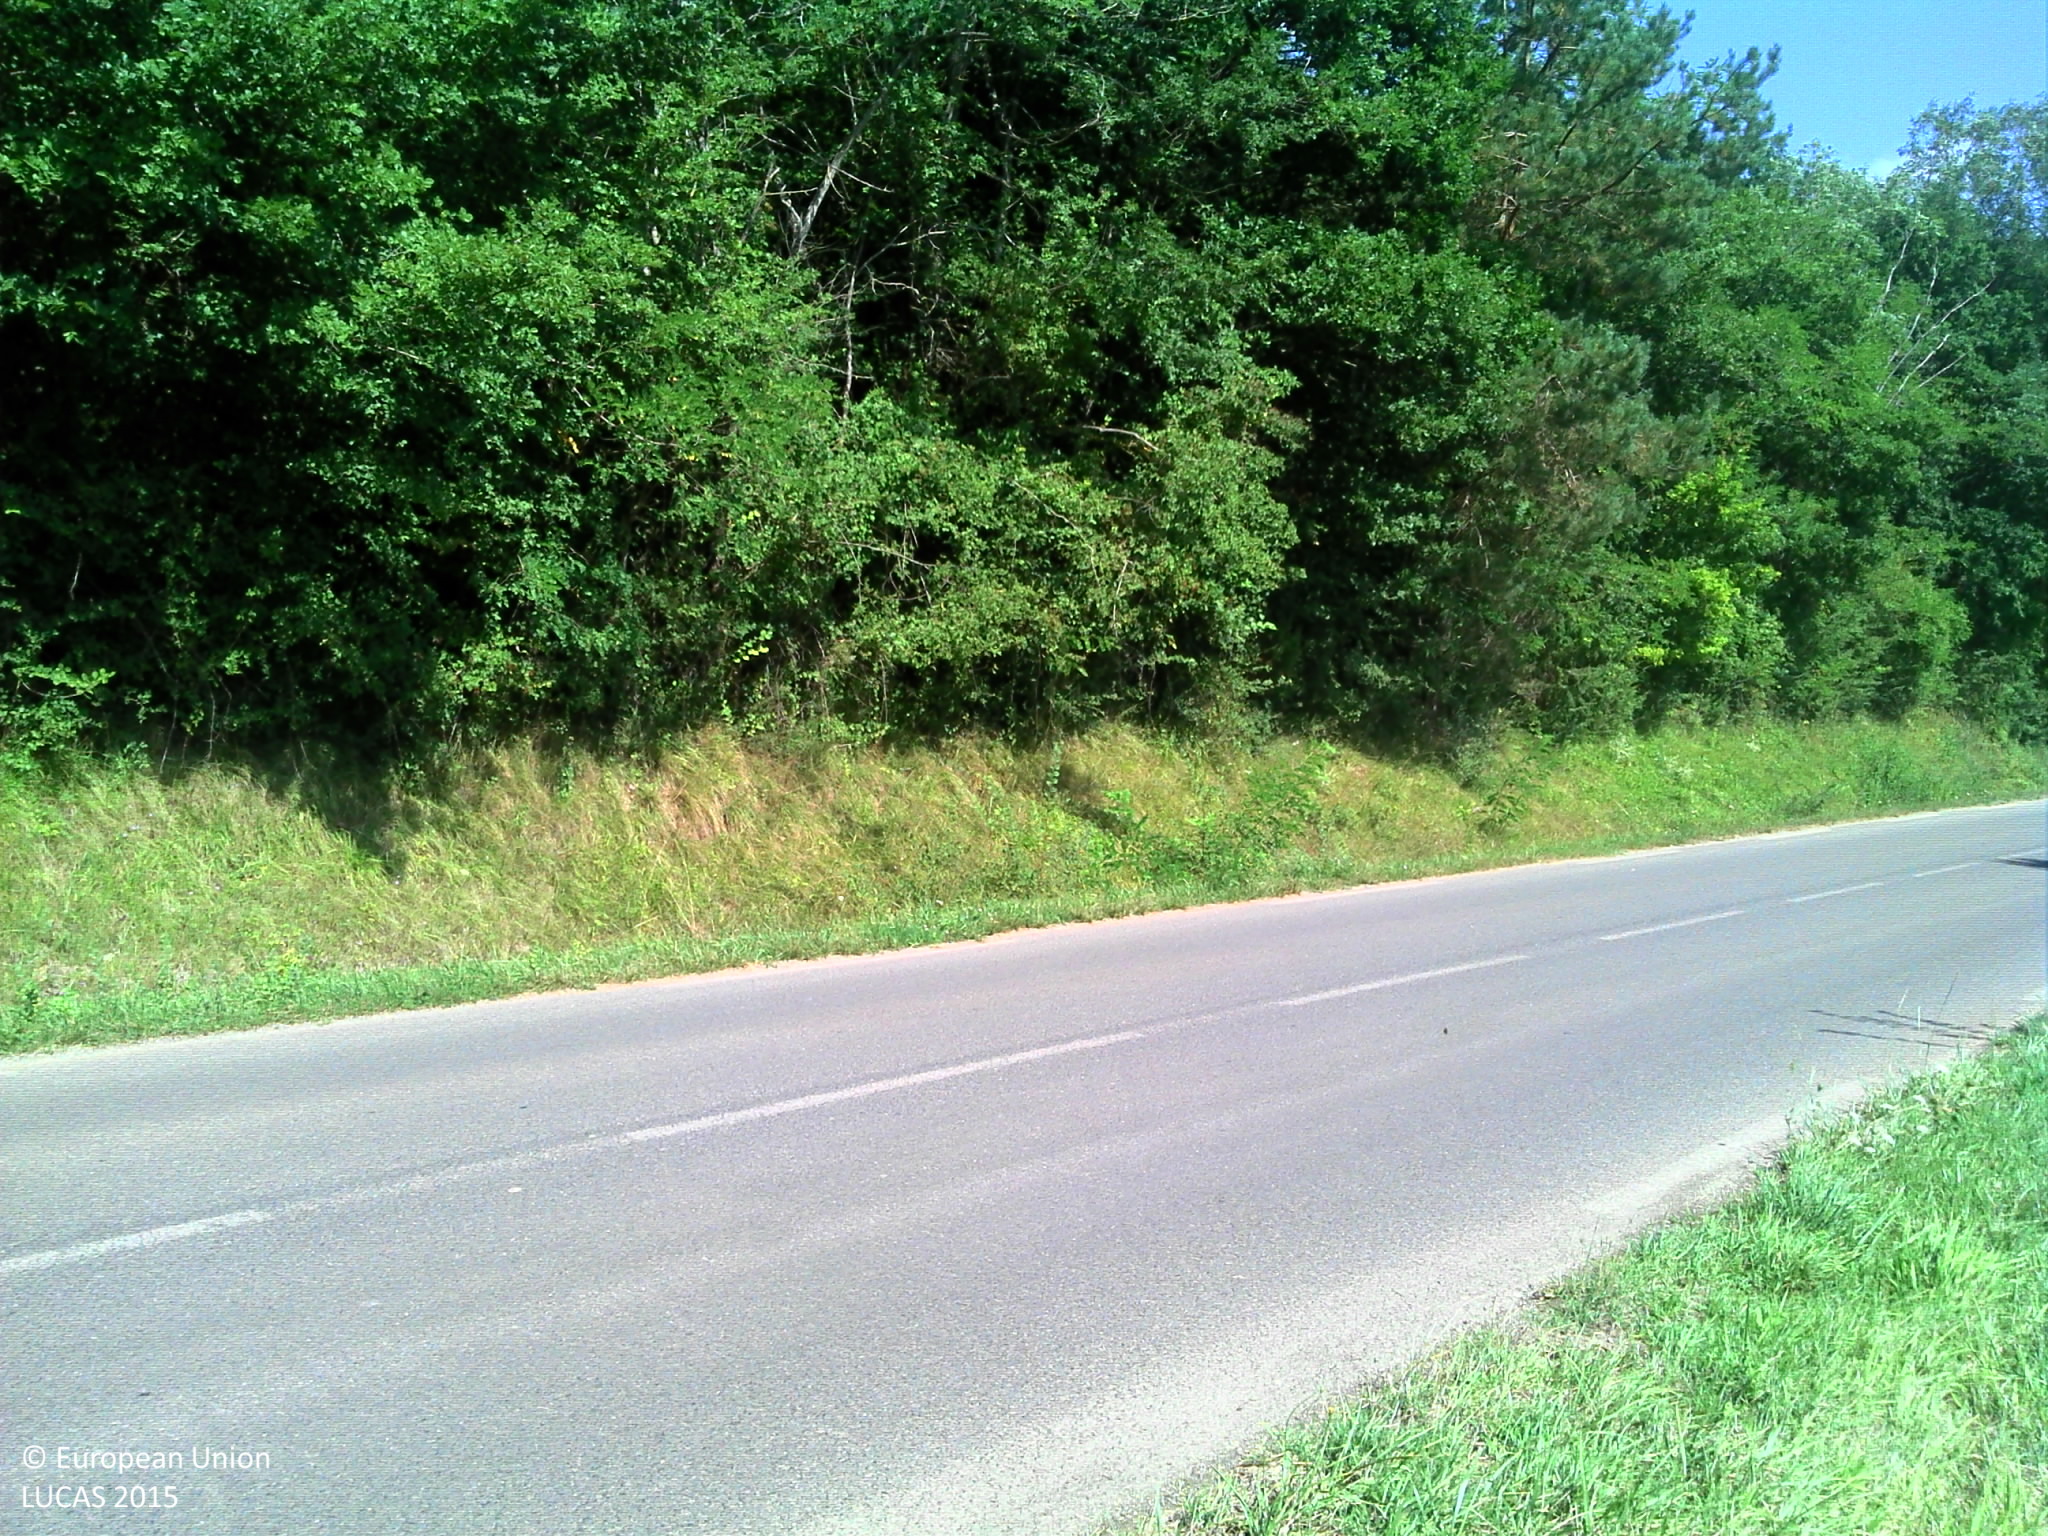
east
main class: Cropland
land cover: Maize
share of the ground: > 75 %
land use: Agriculture (excluding fallow land and kitchen gardens)
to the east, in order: Maize; Spontaneously vegetated surfaces; Abandoned hedges; Grass margins; Paved roads, cycling and walking lanes; Grass margins; Abandoned hedges; Spontaneously vegetated surfaces; Abandoned hedges; Grass margins; Paved roads, cycling and walking lanes; Fences; Broadleaved woodland
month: August
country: FR
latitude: 45.2787
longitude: 0.7477
